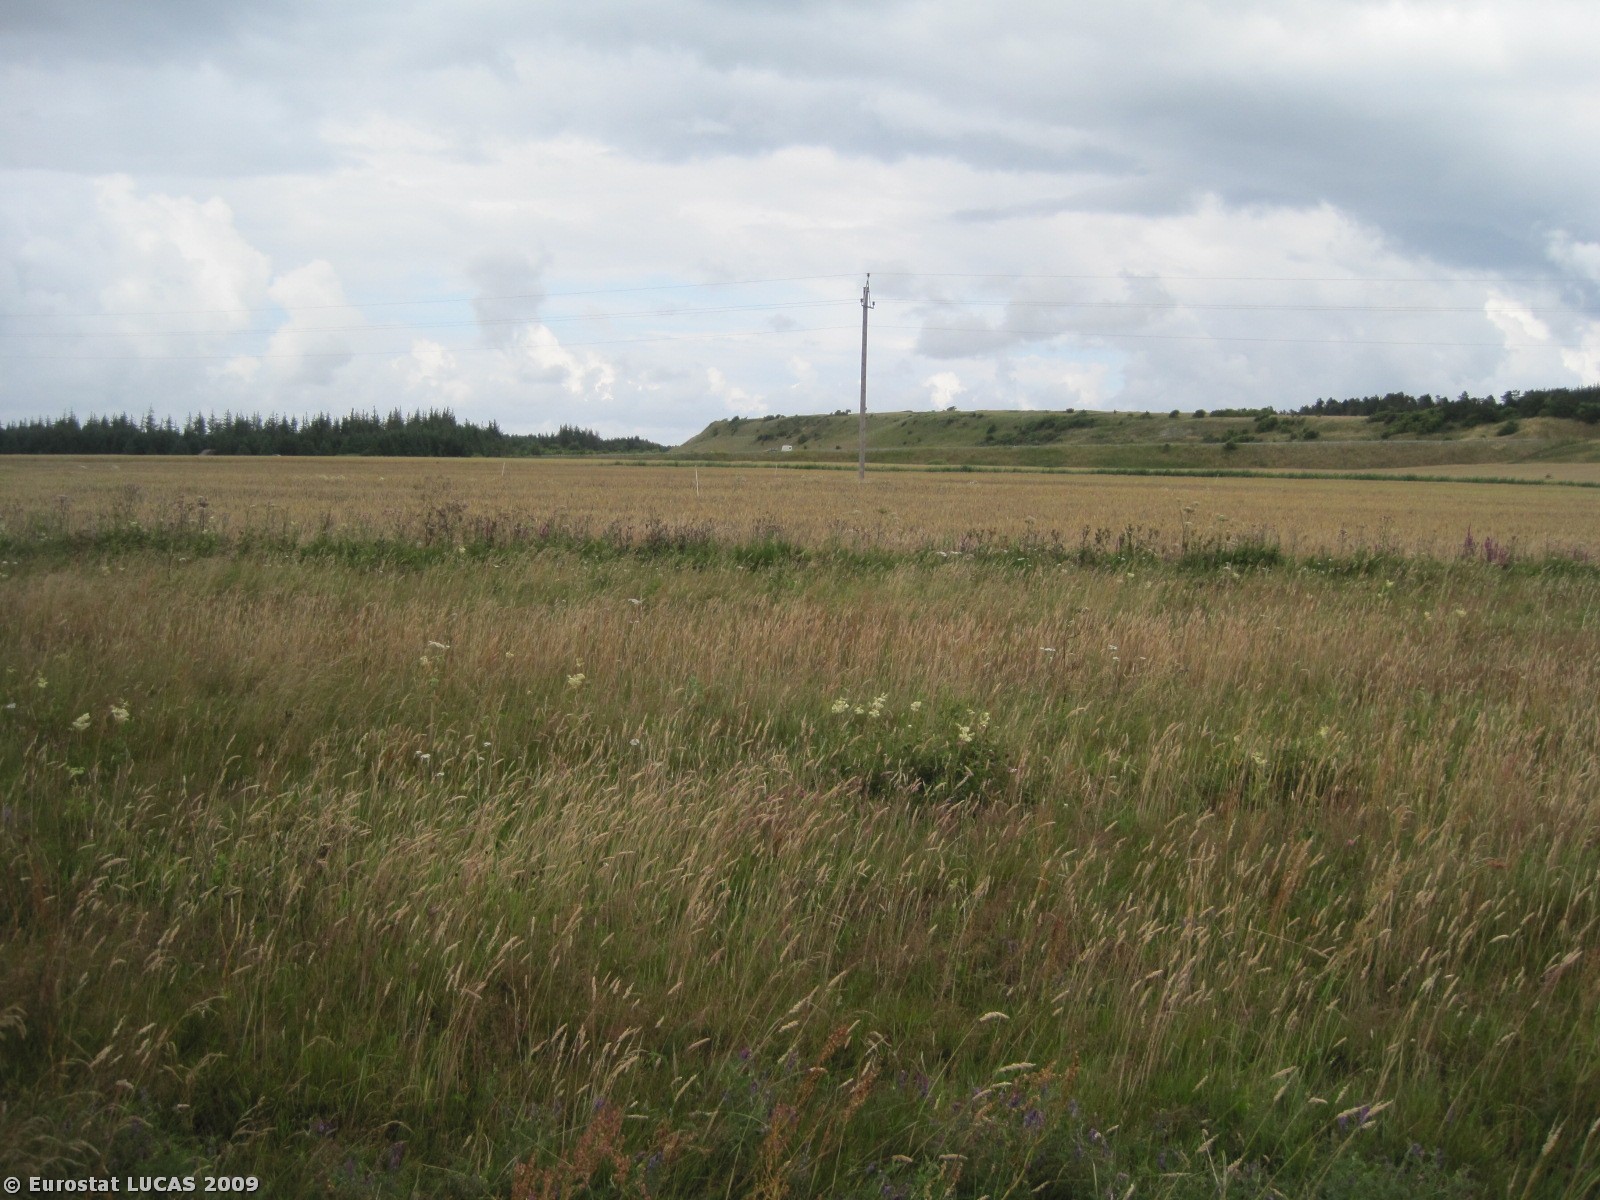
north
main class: Grassland
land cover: Grassland without tree/shrub cover
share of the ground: > 75 %
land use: Unused
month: July
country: DK
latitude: 57.0628
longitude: 8.7651
